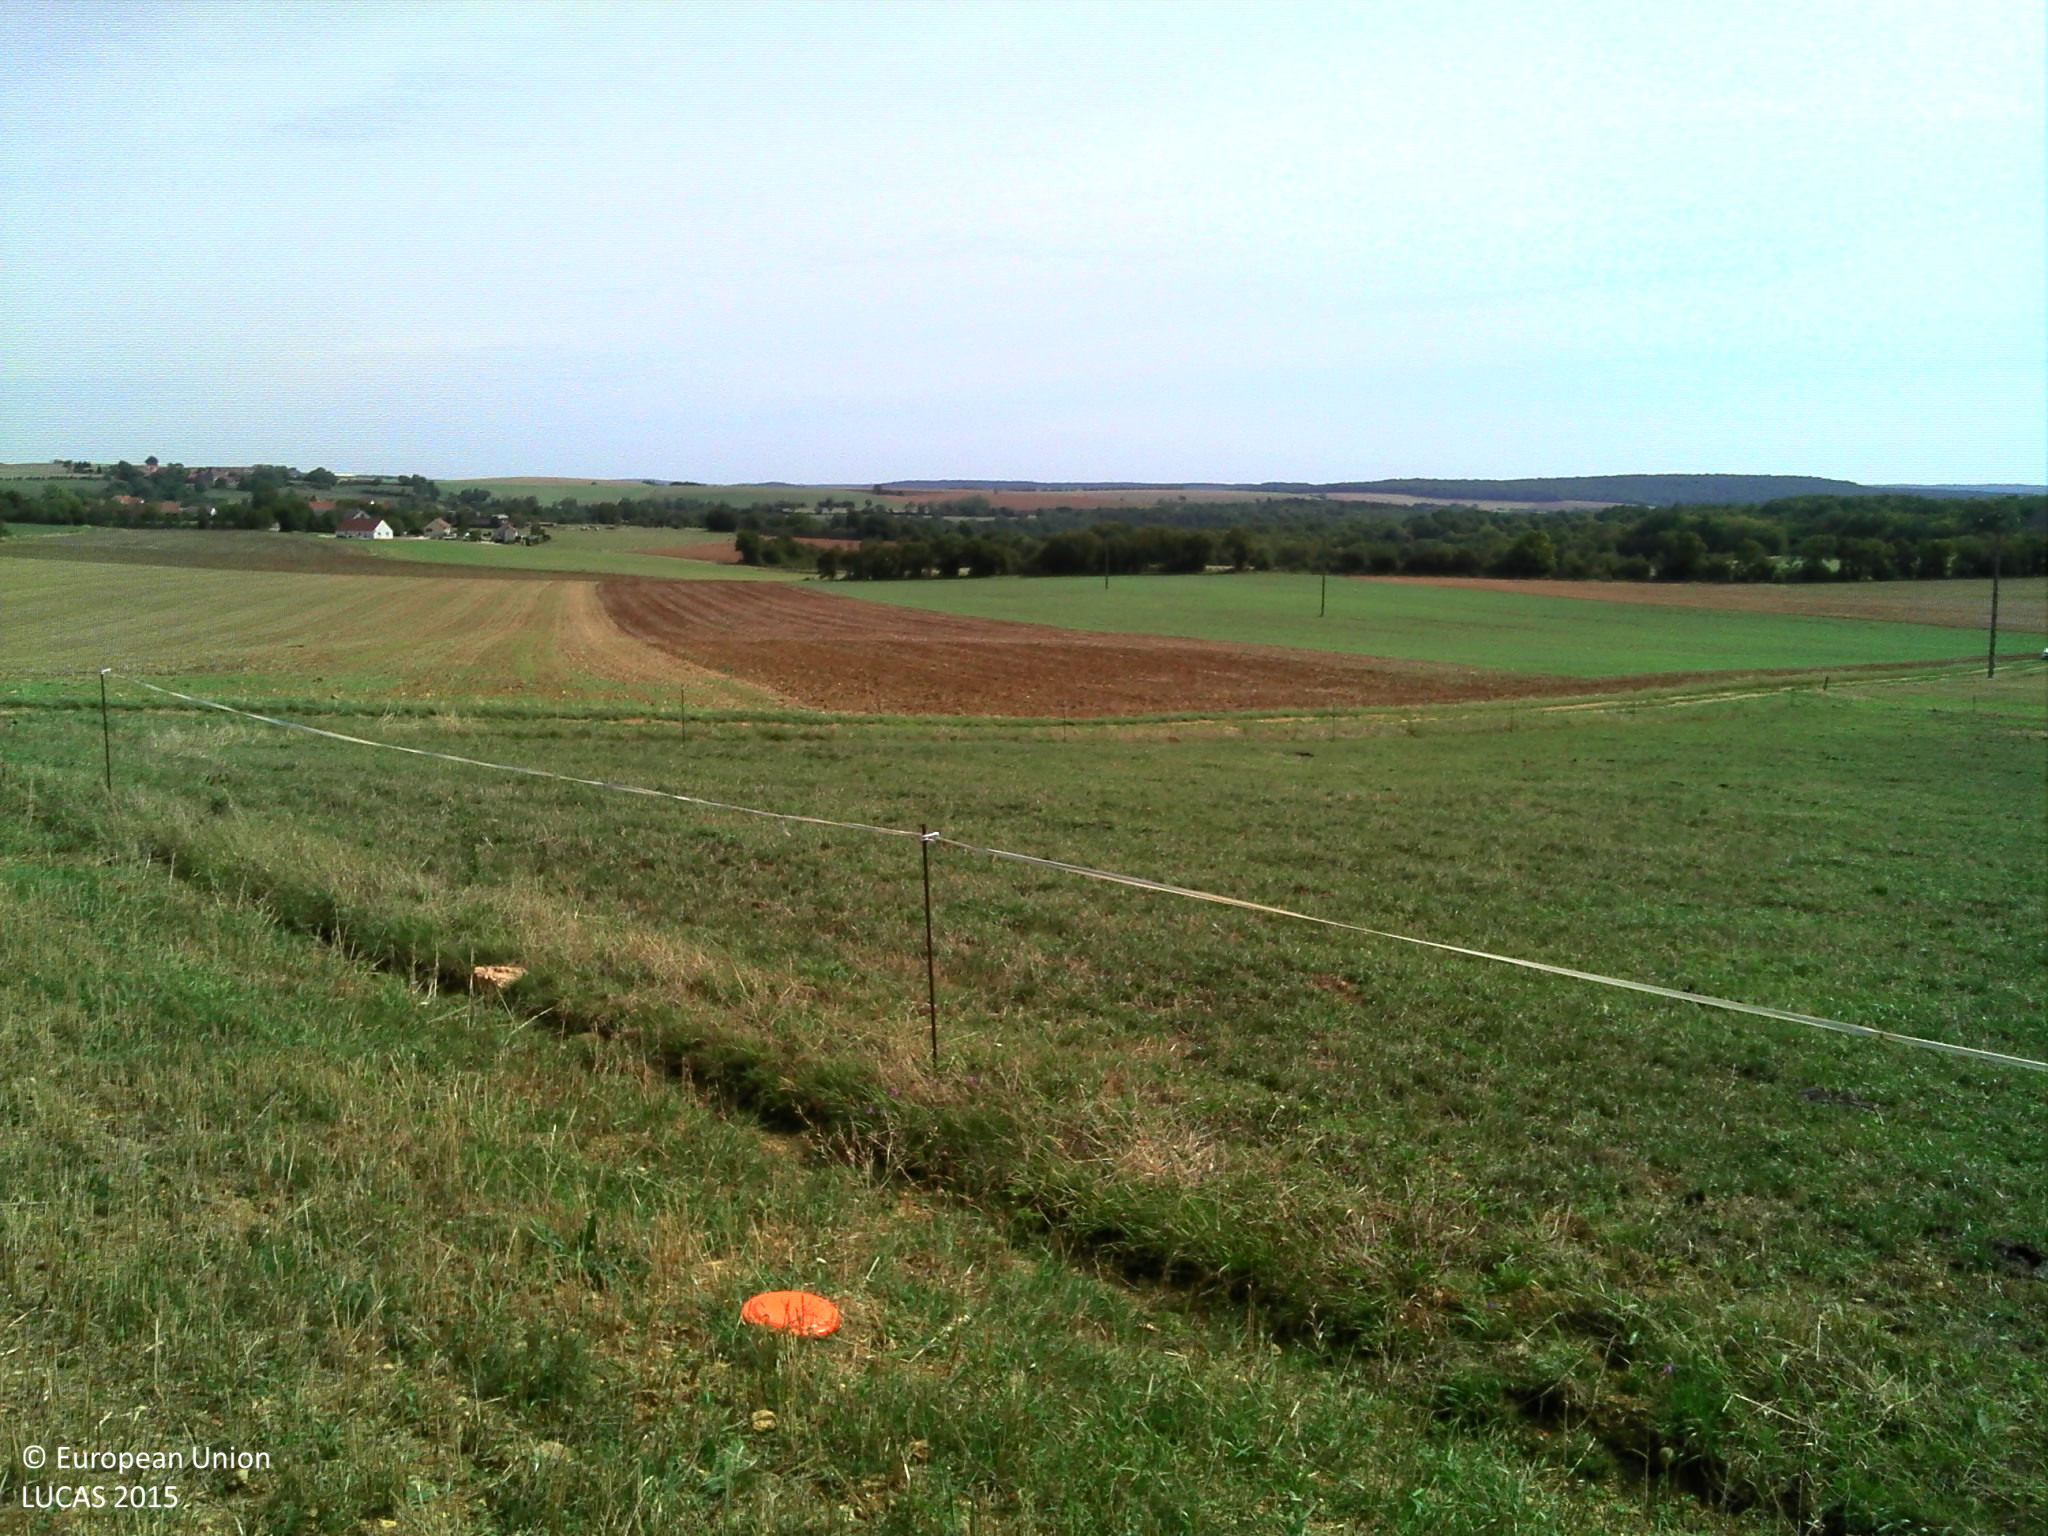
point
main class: Cropland
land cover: Oats
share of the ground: > 75 %
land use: Agriculture (excluding fallow land and kitchen gardens)
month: August
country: FR
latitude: 47.6572
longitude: 4.9534
